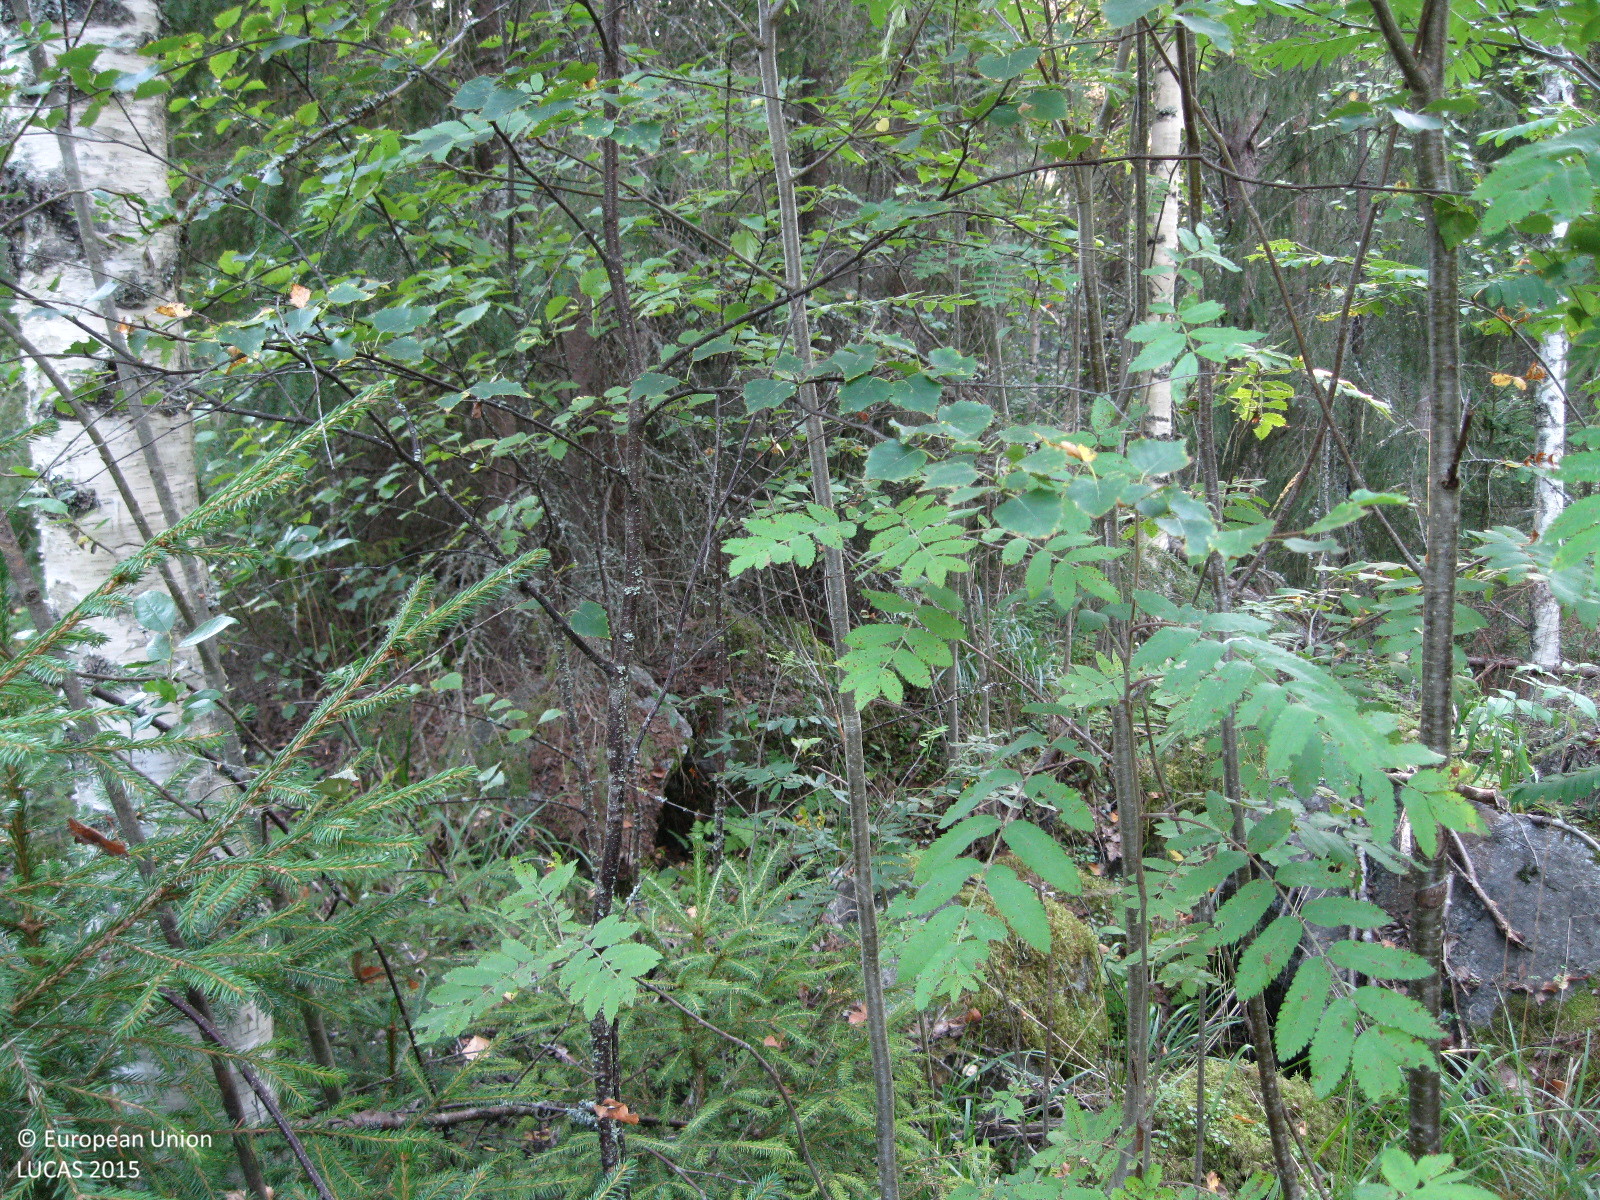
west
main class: Woodland
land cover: Spruce dominated mixed woodland
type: boreal forest
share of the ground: 50 - 75 %
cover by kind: coniferous forest trees 50 %, herbaceous plants 30 %, broadleaved forest trees 20 %
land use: Forestry
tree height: > 5 m
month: August
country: FI
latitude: 61.3796
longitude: 25.1414
